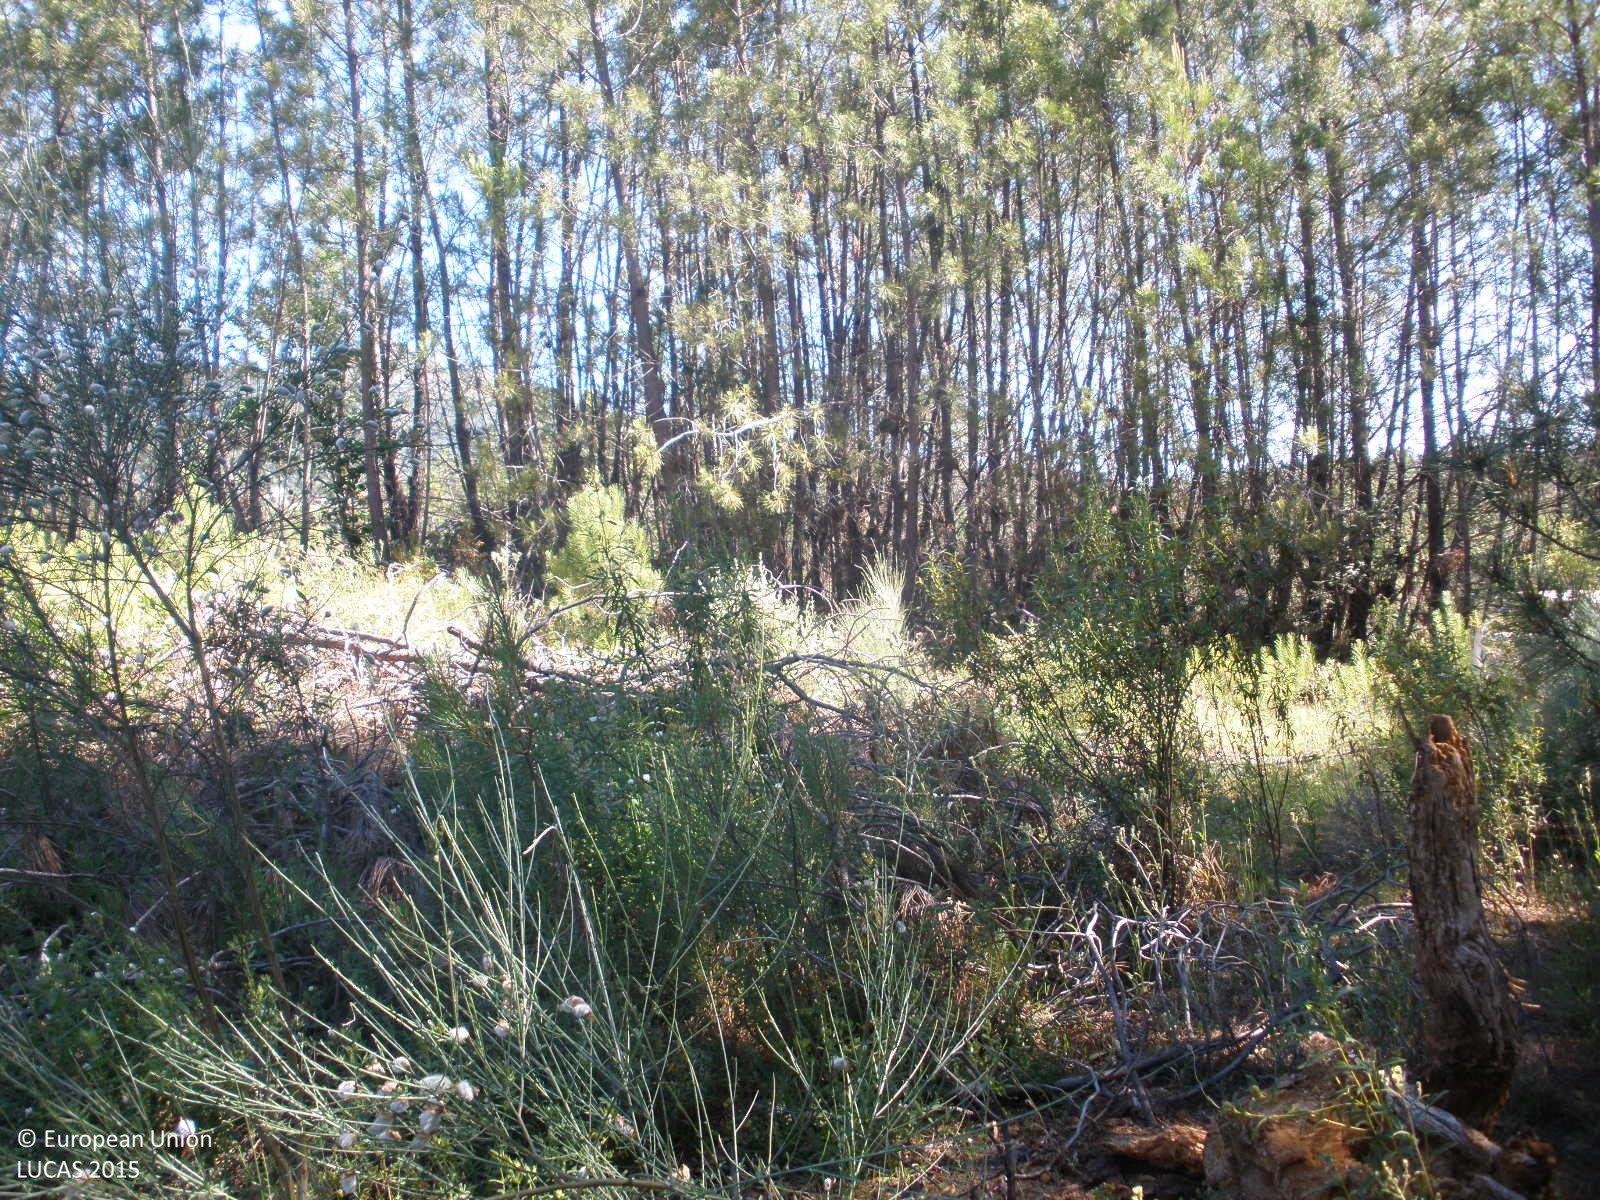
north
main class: Woodland
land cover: Pine dominated coniferous woodland
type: coniferous forest of the mediterranean region
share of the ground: > 75 %
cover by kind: coniferous forest trees 90 %, shrubs 10 %
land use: Forestry
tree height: > 5 m
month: May
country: ES
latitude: 40.2106
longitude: -6.5688
